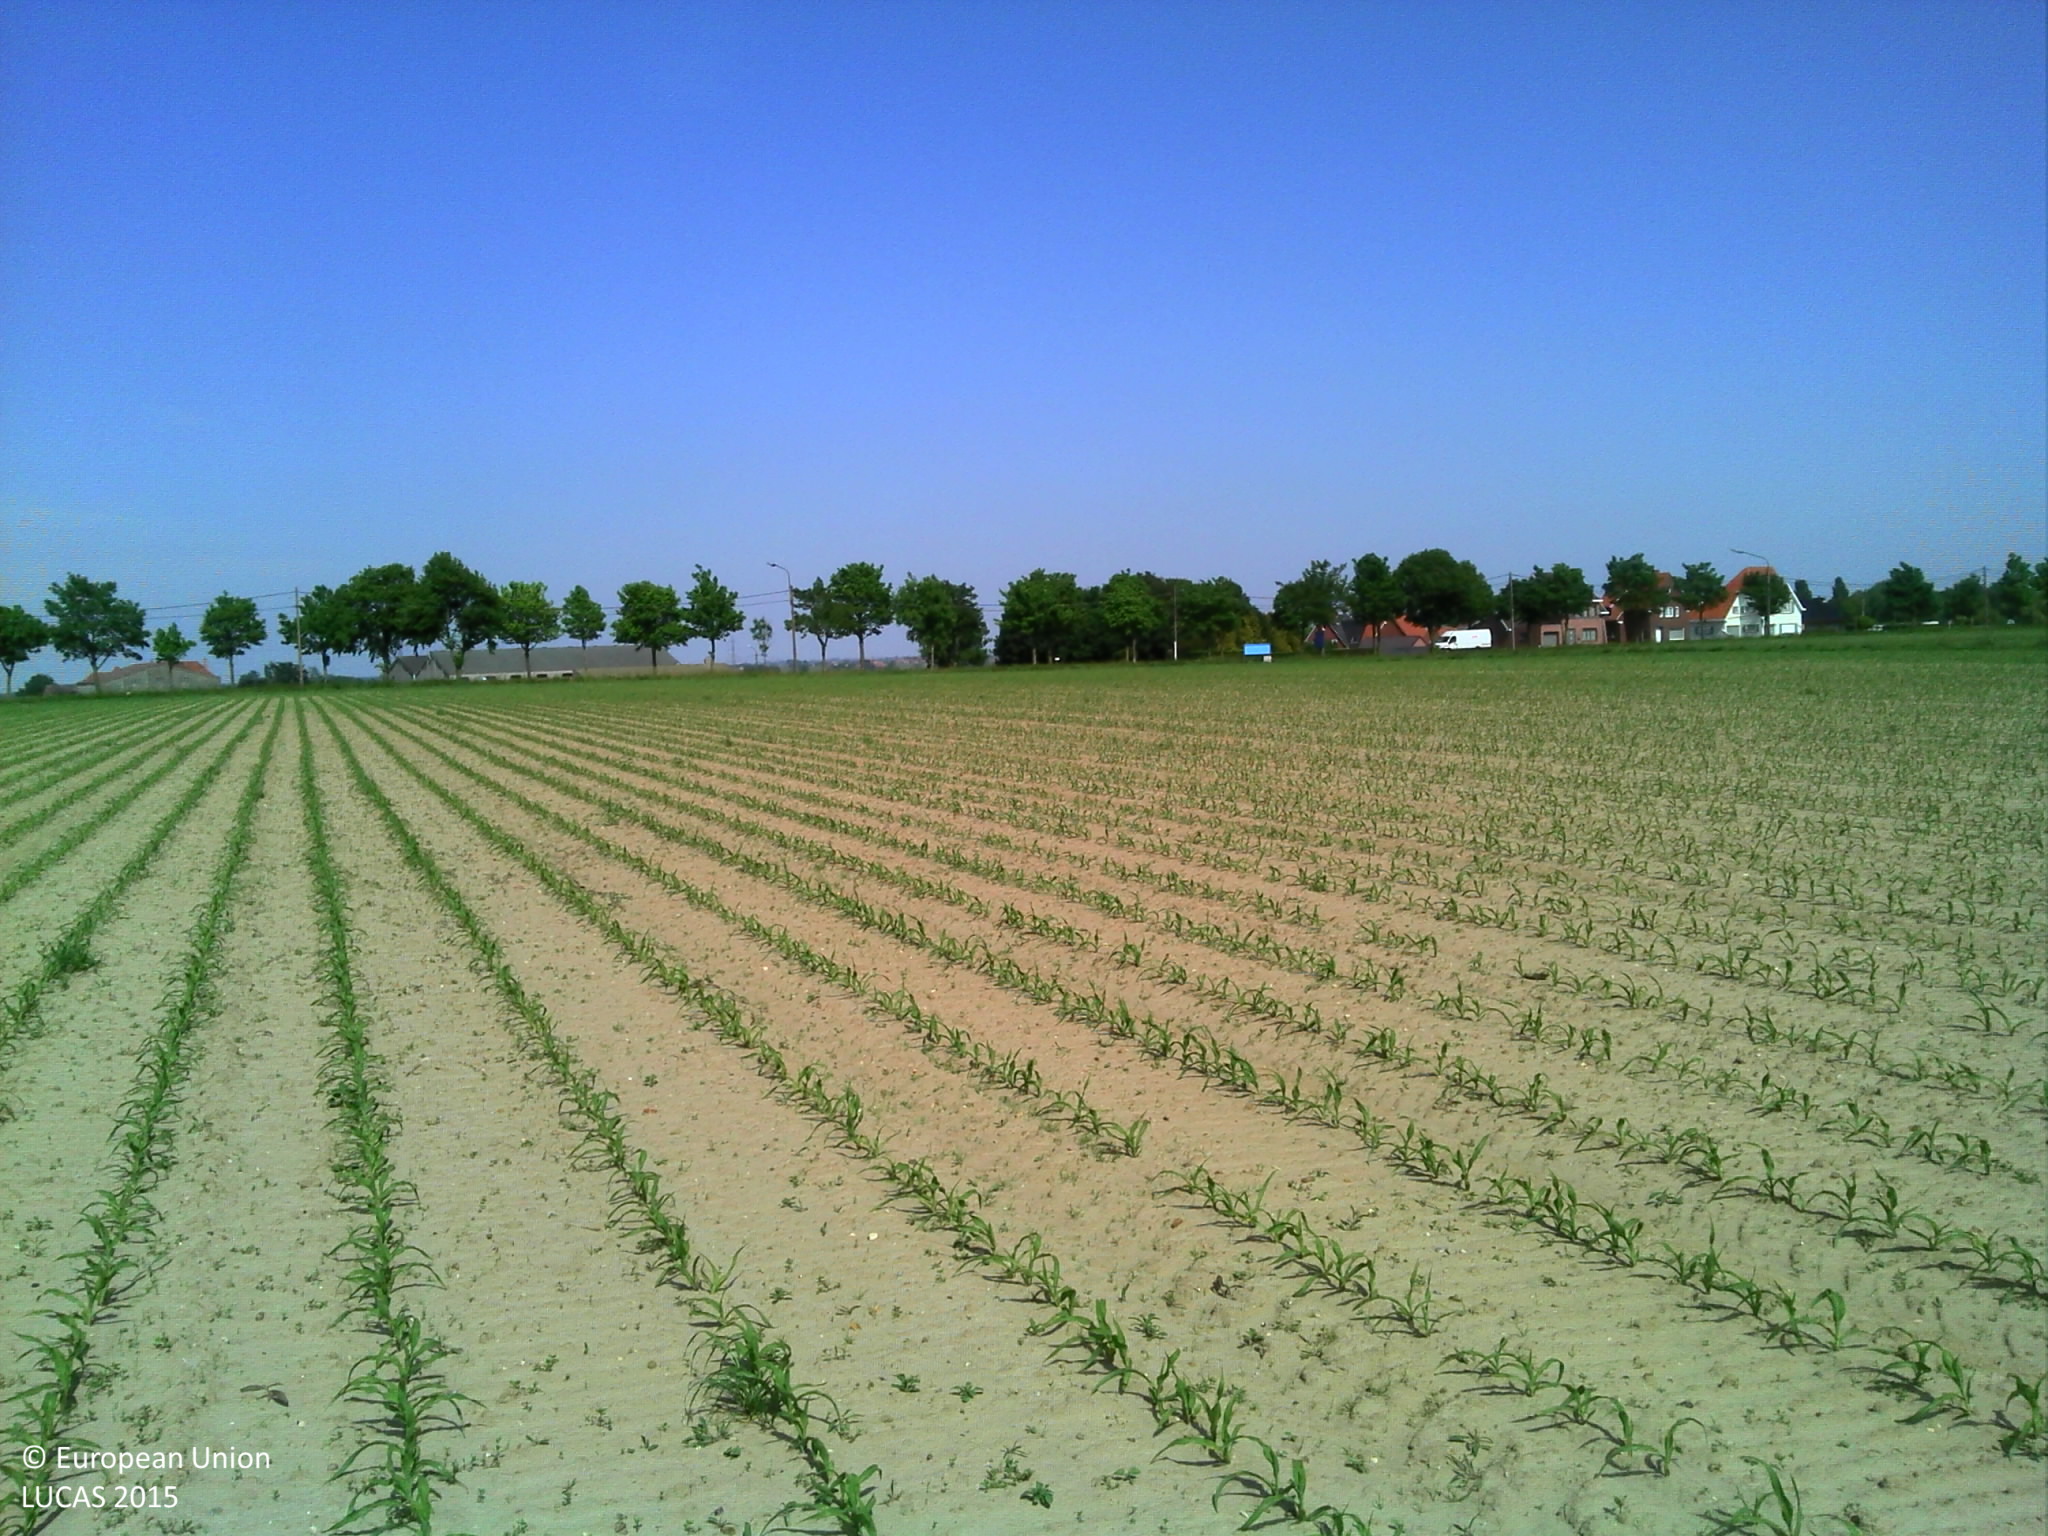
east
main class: Cropland
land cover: Maize
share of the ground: < 10 %
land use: Agriculture (excluding fallow land and kitchen gardens)
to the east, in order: Maize; Grass margins; Lines of trees; Electric lines; Tracks; Paved roads, cycling and walking lanes; Grass margins; Lines of trees; Grass margins; Common wheat
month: June
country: BE
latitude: 50.8543
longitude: 3.0152
